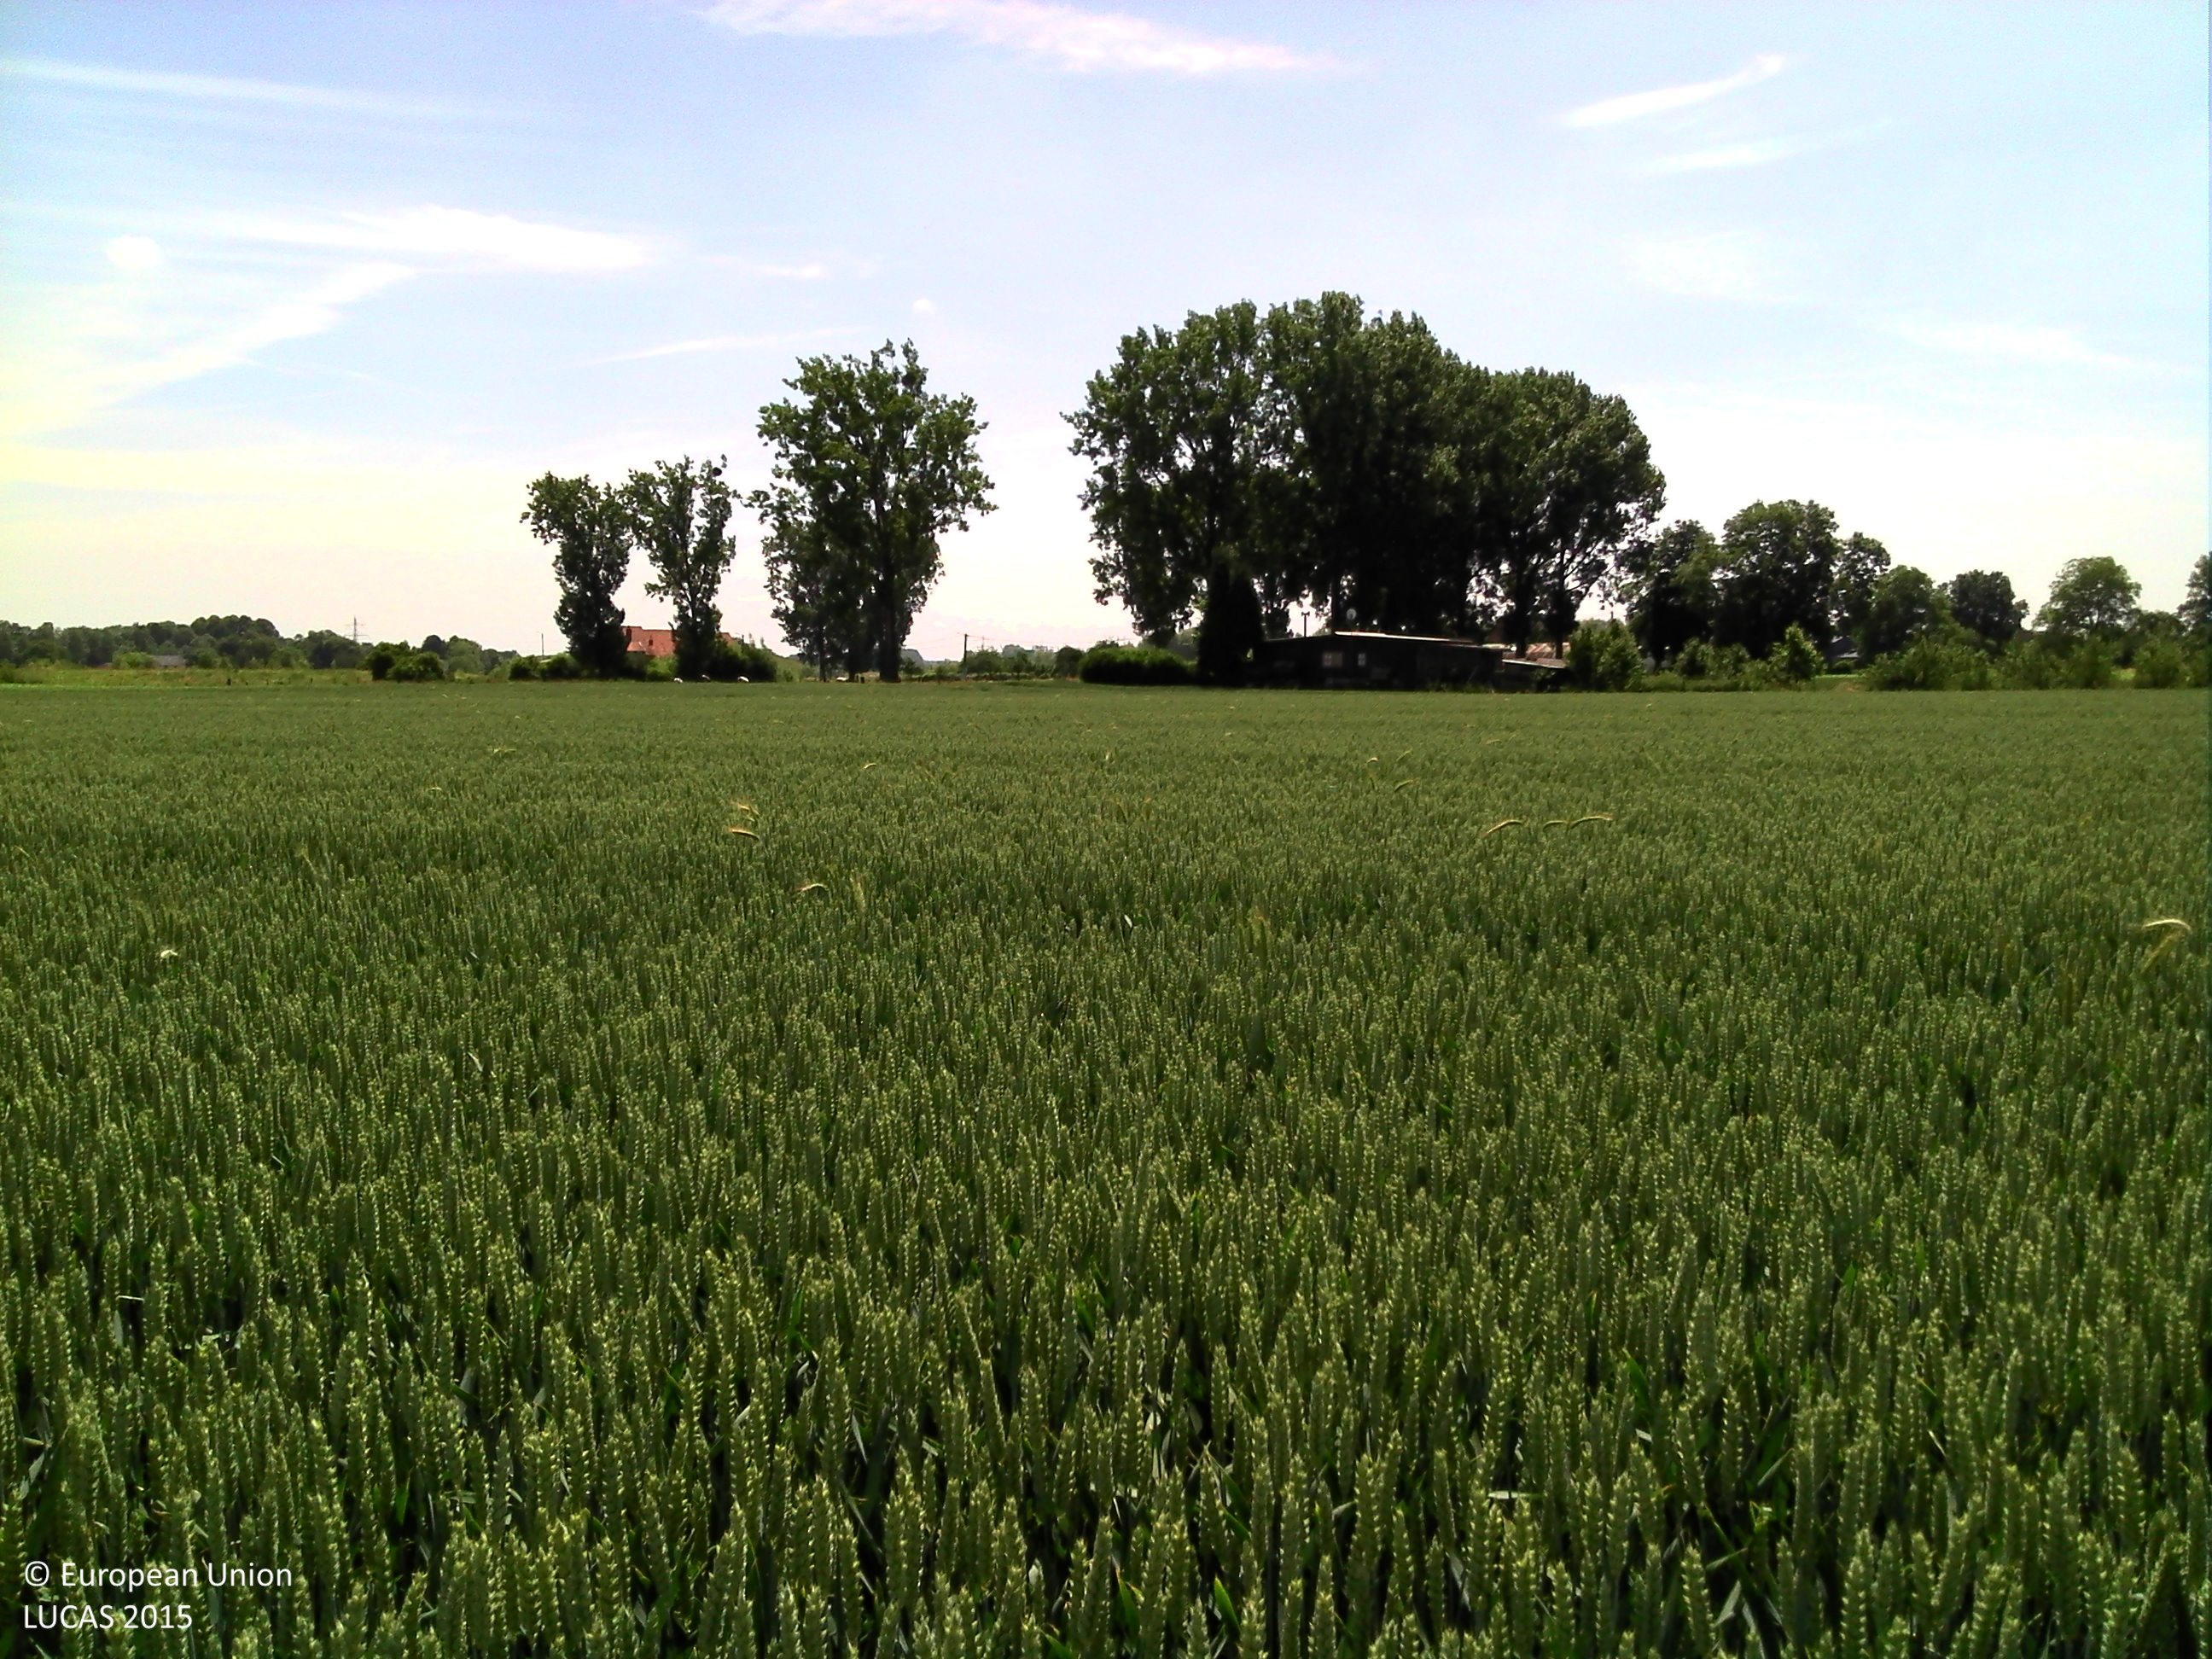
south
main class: Cropland
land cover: Common wheat
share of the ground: > 75 %
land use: Agriculture (excluding fallow land and kitchen gardens)
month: June
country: BE
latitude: 50.9141
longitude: 5.7173
